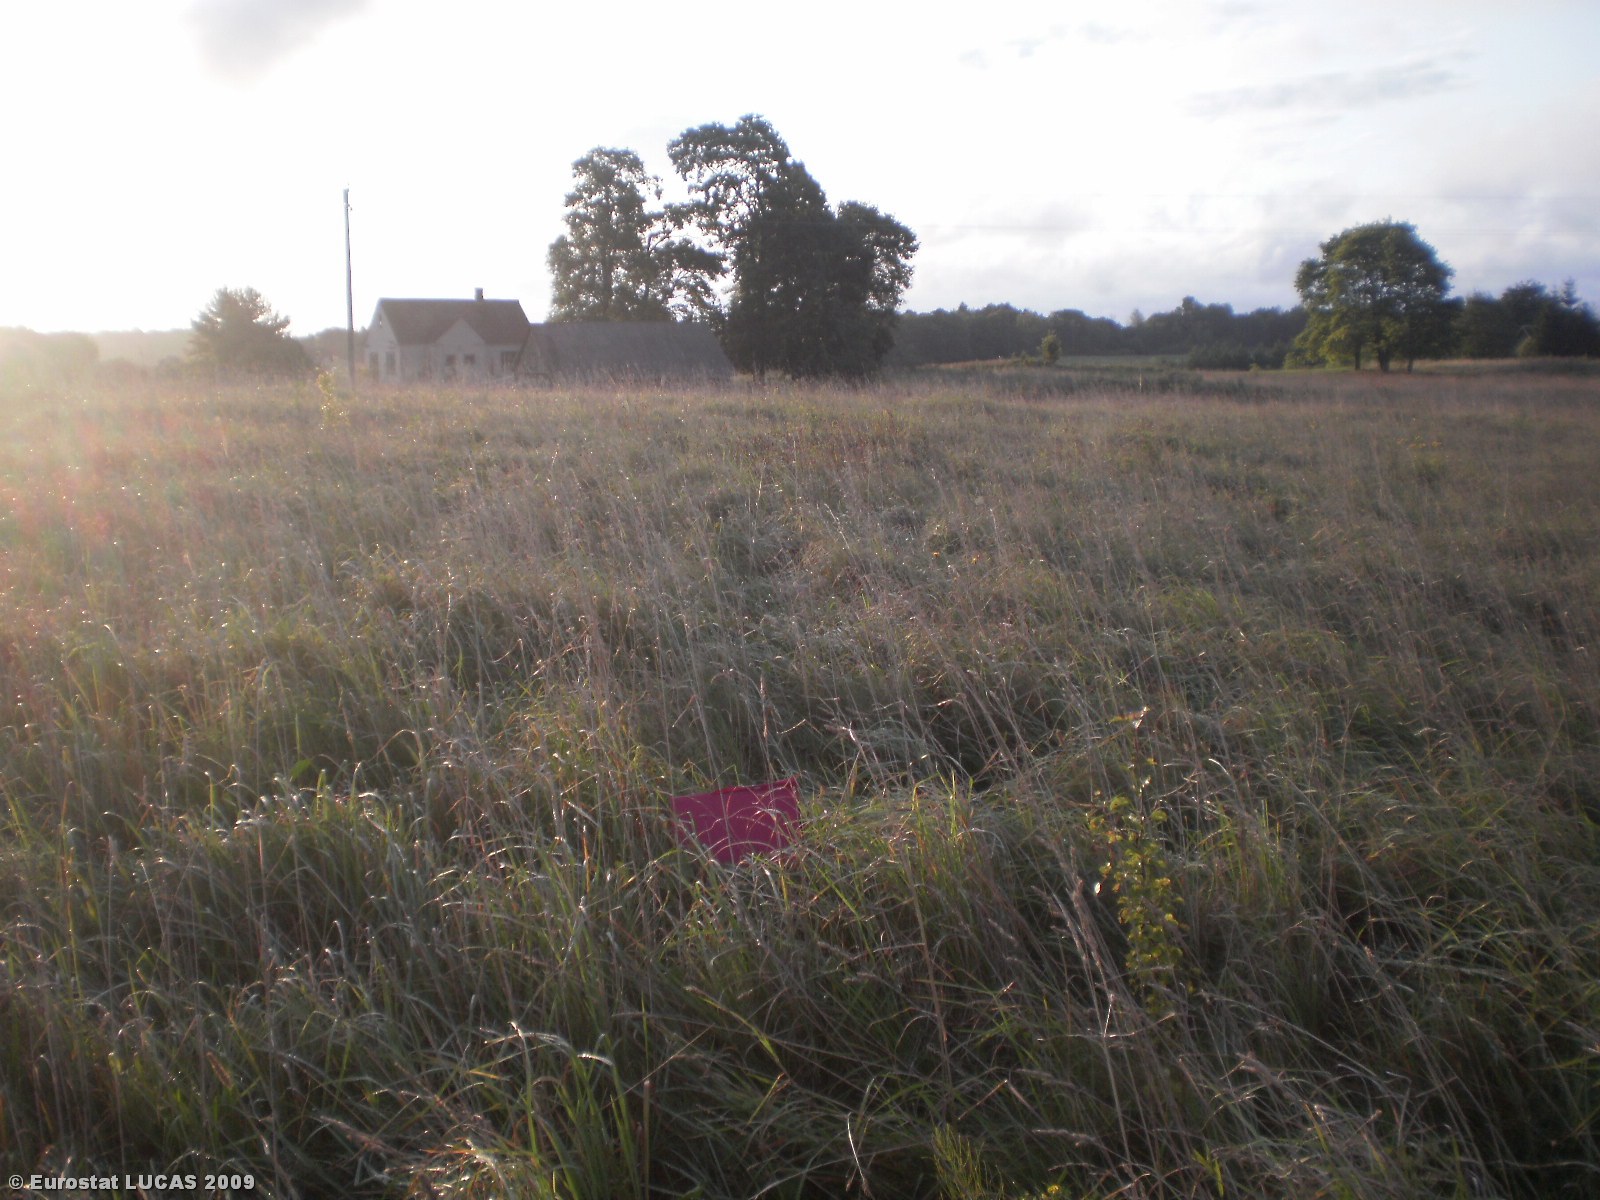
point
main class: Grassland
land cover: Grassland without tree/shrub cover
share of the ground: > 75 %
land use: Agriculture (excluding fallow land and kitchen gardens)
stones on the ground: 10 - 25 %
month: August
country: LT
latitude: 55.0949
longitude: 25.4658
